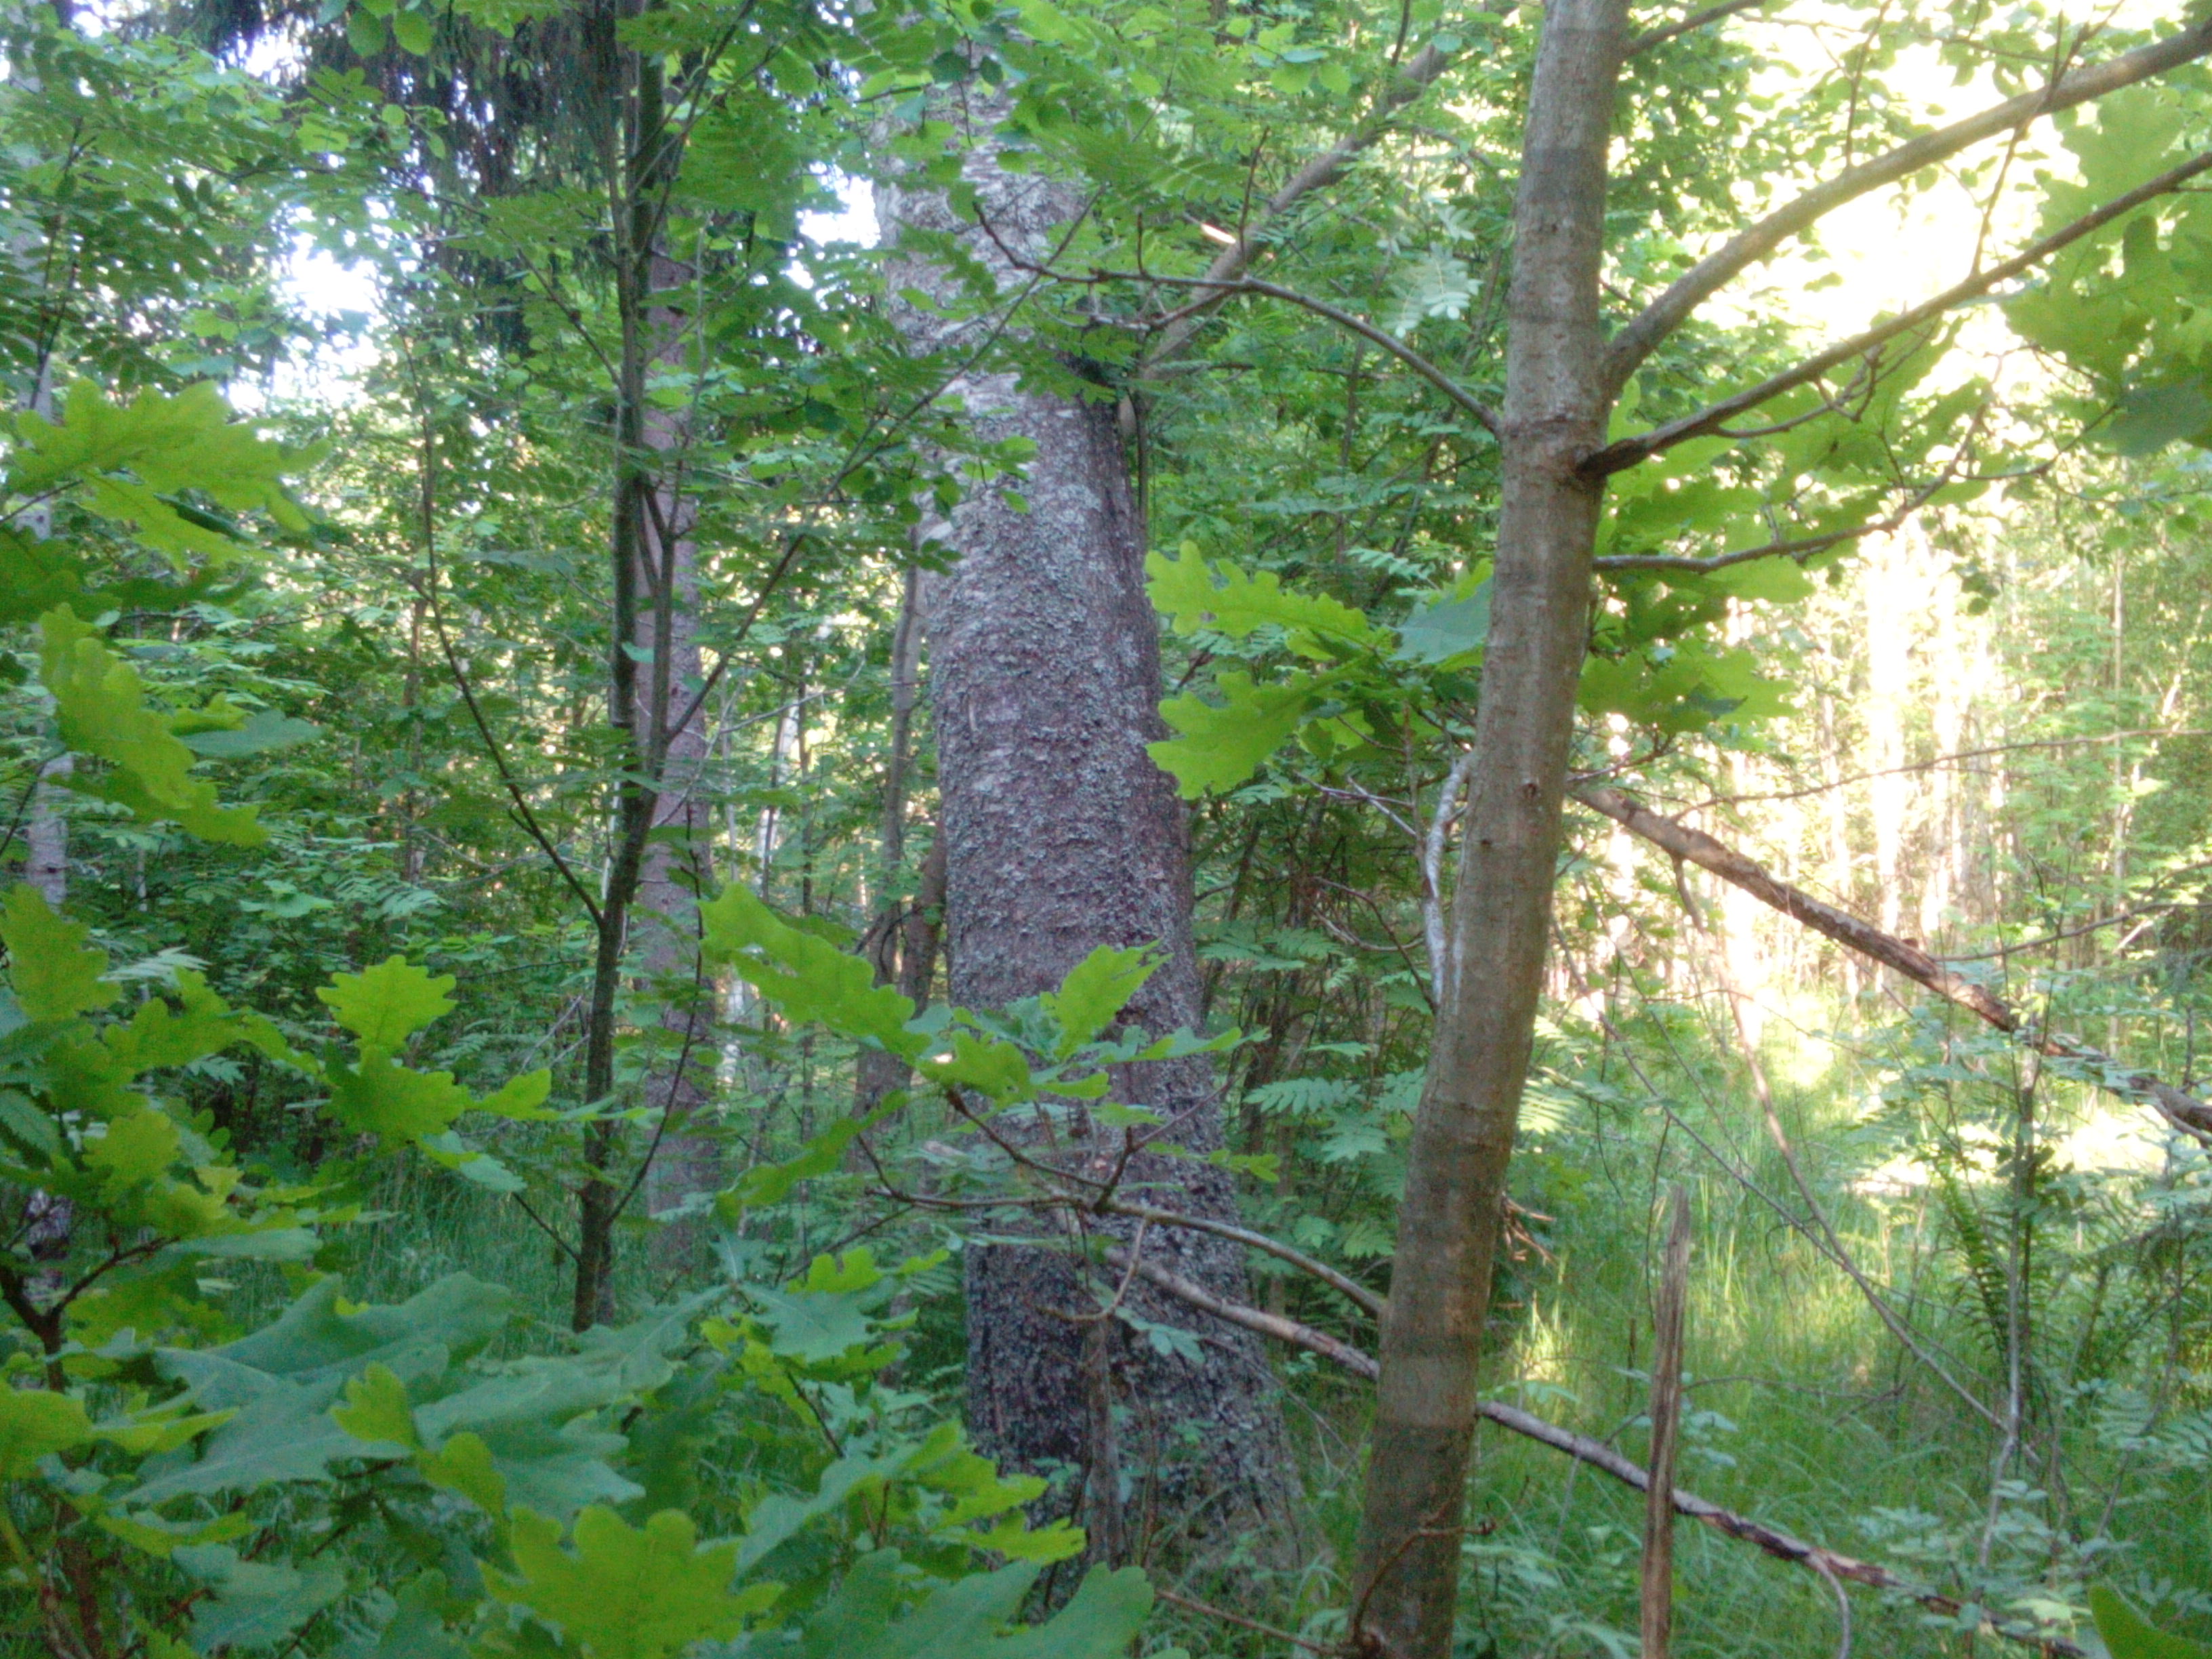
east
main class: Woodland
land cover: Spruce dominated mixed woodland
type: hemiboreal forest and nemoral coniferous forest and mixed broadleaved-coniferous forest
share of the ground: > 75 %
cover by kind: broadleaved forest trees 60 %, coniferous forest trees 30 %, shrubs 10 %
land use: Forestry
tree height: > 5 m
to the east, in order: Spruce dominated mixed woodland; Tracks; Broadleaved woodland; Spruce dominated mixed woodland; Broadleaved woodland; Spruce dominated mixed woodland
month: June
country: LV
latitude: 56.8031
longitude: 22.2190
